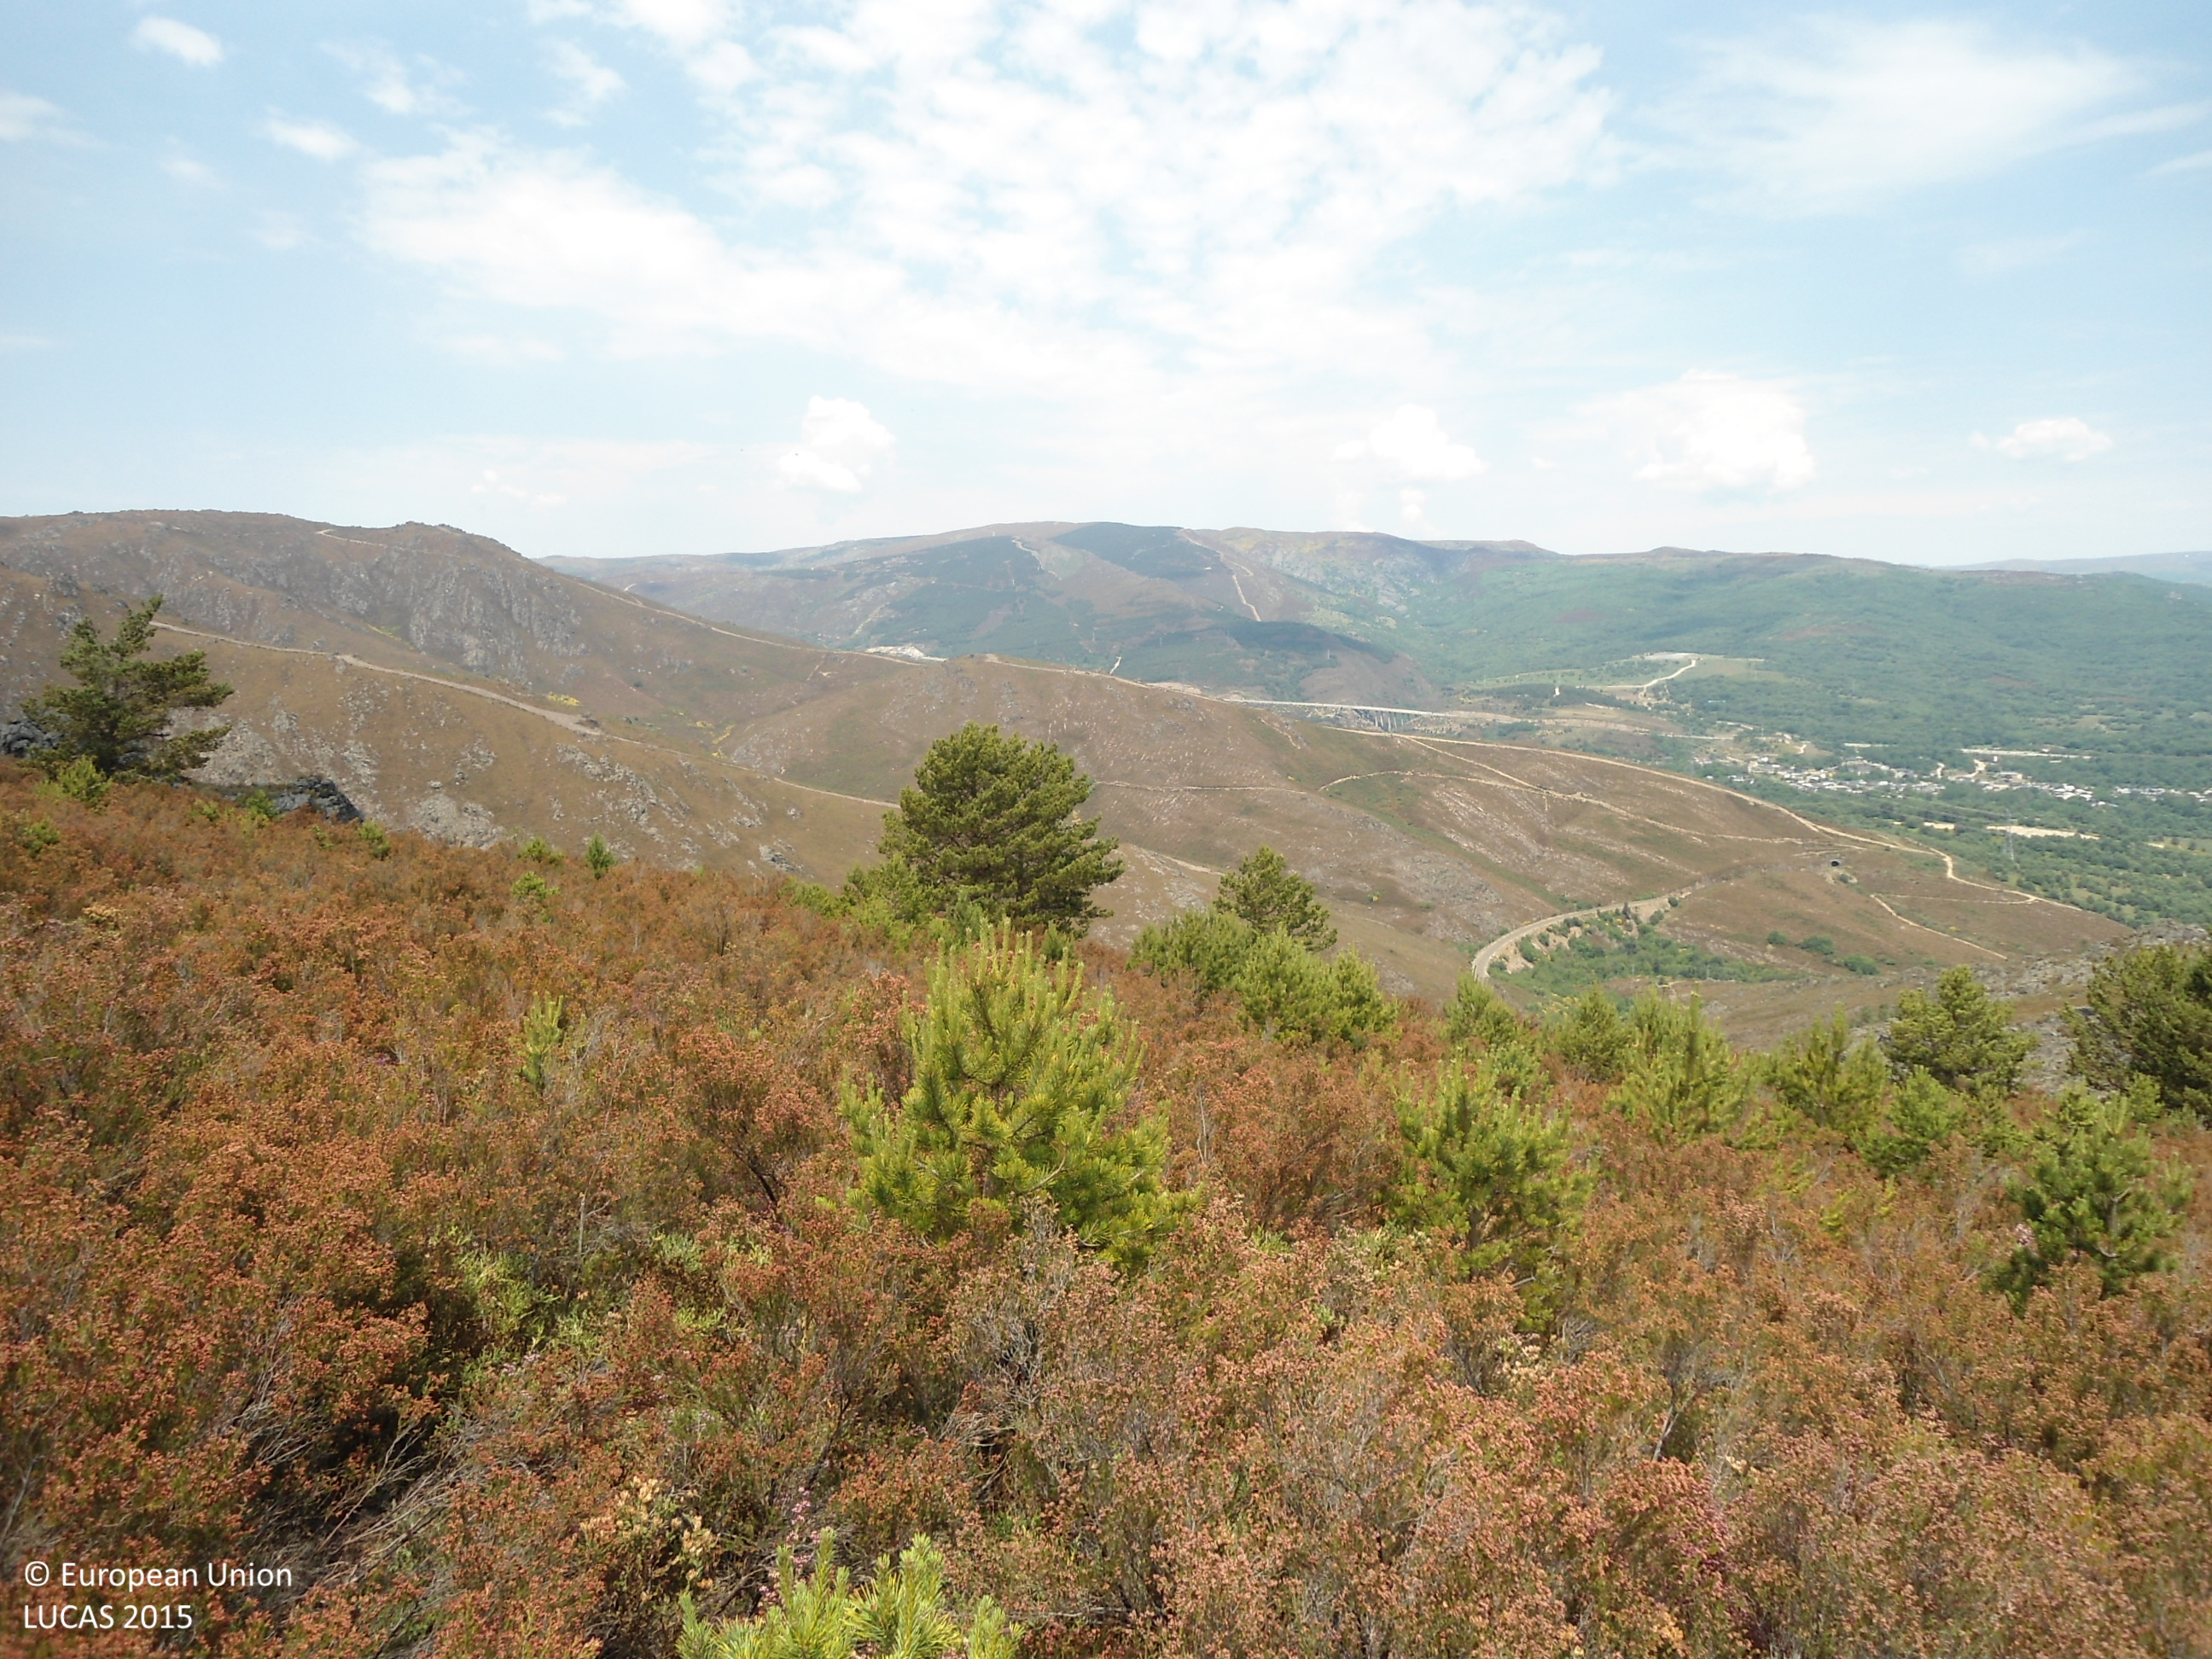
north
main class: Woodland
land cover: Pine dominated coniferous woodland
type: coniferous forest of the mediterranean region
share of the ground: 10 - 25 %
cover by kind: shrubs 90 %, coniferous forest trees 10 %
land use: Forestry
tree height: < 5 m
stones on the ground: > 50 %
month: June
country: ES
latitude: 42.0037
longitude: -6.7408
